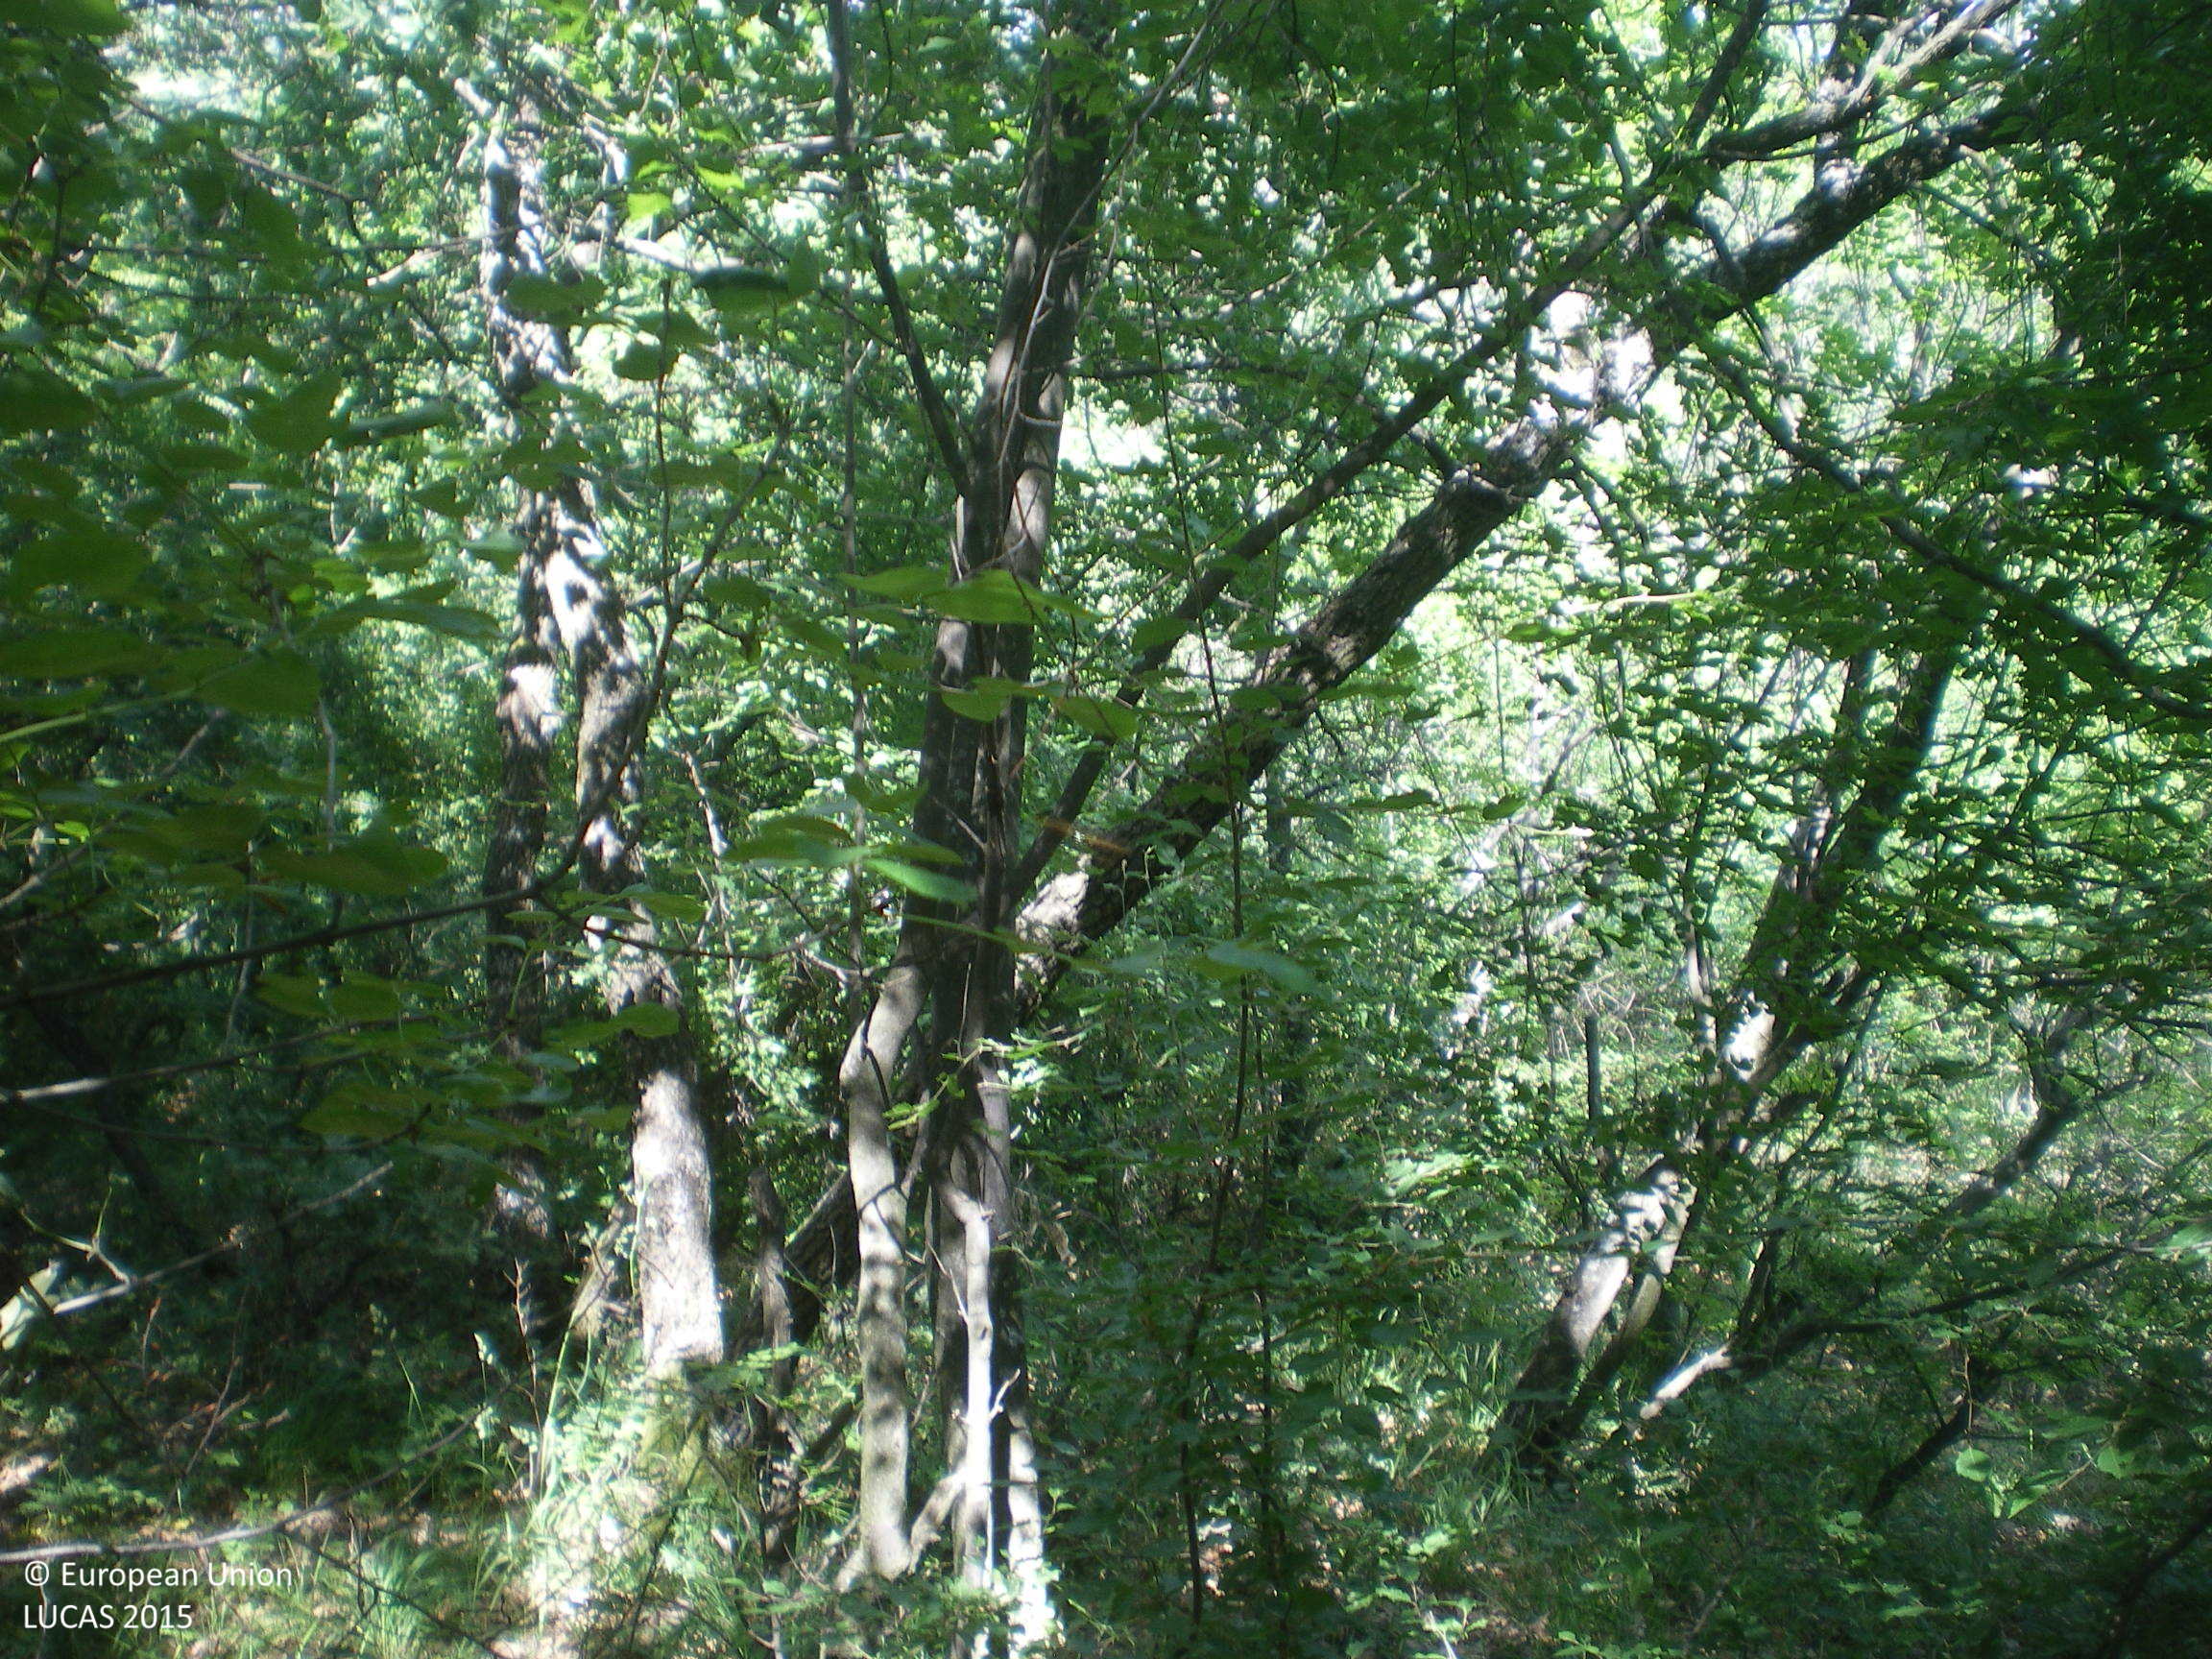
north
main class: Woodland
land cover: Broadleaved woodland
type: mesophytic deciduous forest
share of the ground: > 75 %
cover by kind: broadleaved forest trees 80 %, shrubs 15 %, herbaceous plants 5 %
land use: Forestry
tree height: > 5 m
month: June
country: BG
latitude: 42.3976
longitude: 25.5597
